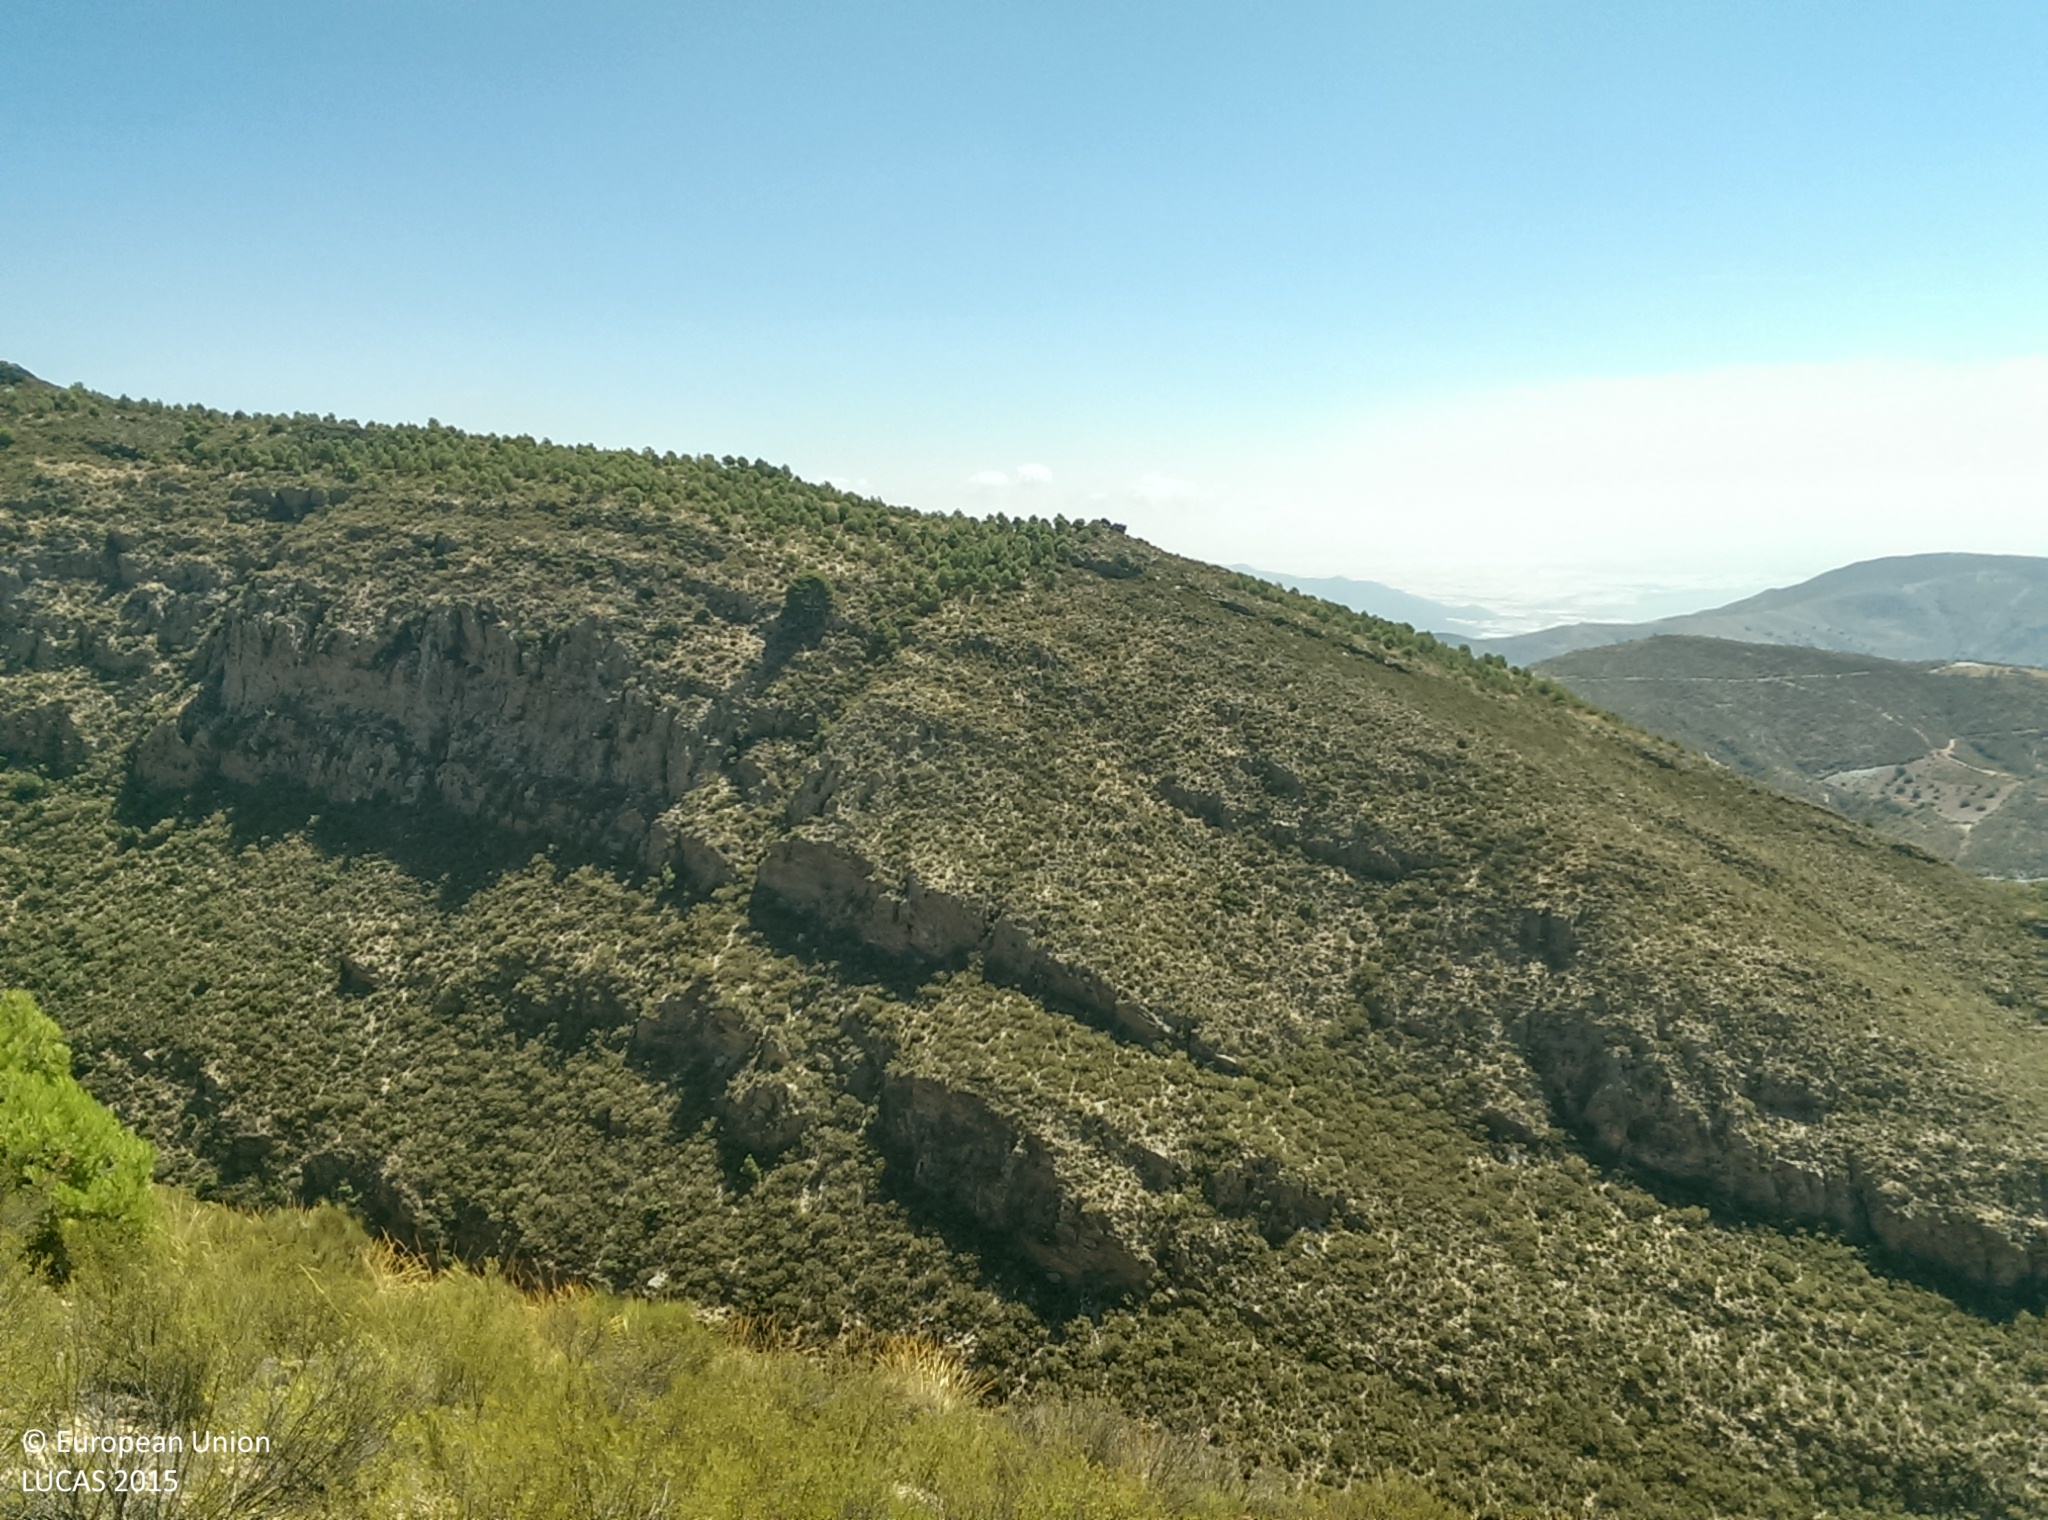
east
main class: Shrubland
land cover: Shrubland without tree cover
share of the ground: 50 - 75 %
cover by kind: shrubs 60 %, herbaceous plants 20 %, unconsolidated bare surface 20 %
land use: Semi-natural and natural areas not in use
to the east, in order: Shrubland without tree cover; Rivers and streams; Shrubland without tree cover
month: August
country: ES
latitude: 36.8178
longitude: -3.1065
